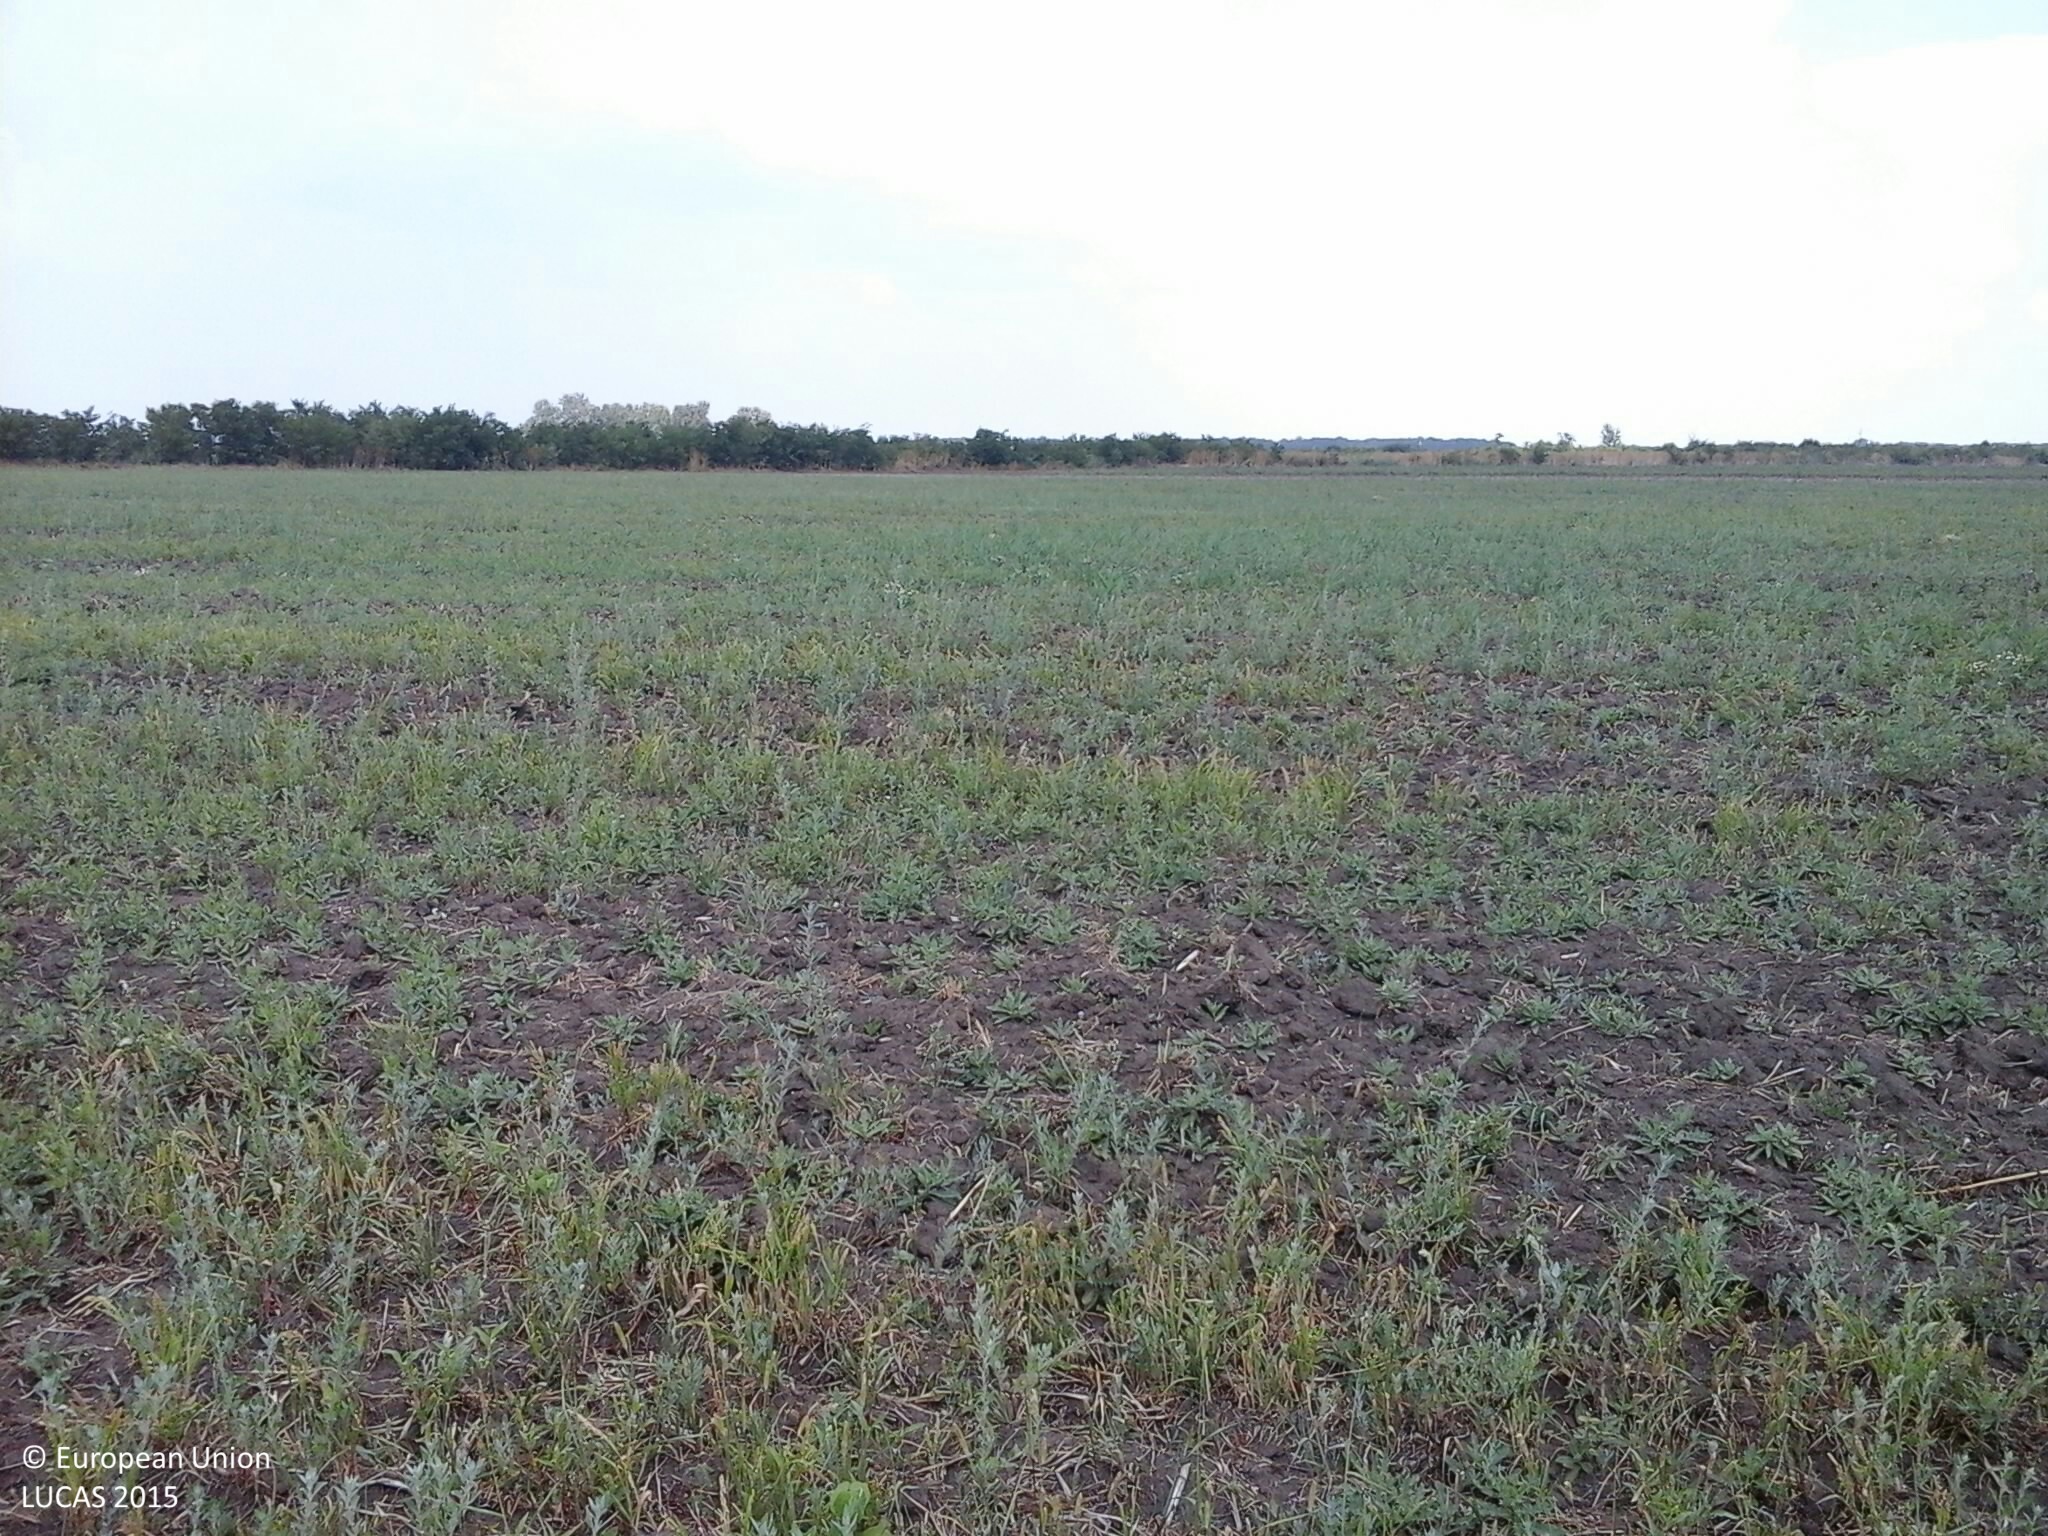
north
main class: Grassland
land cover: Spontaneously vegetated surfaces
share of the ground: 50 - 75 %
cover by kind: herbaceous plants 60 %, unconsolidated bare surface 40 %
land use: Fallow land
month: August
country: HU
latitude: 47.6030
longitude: 20.9569
